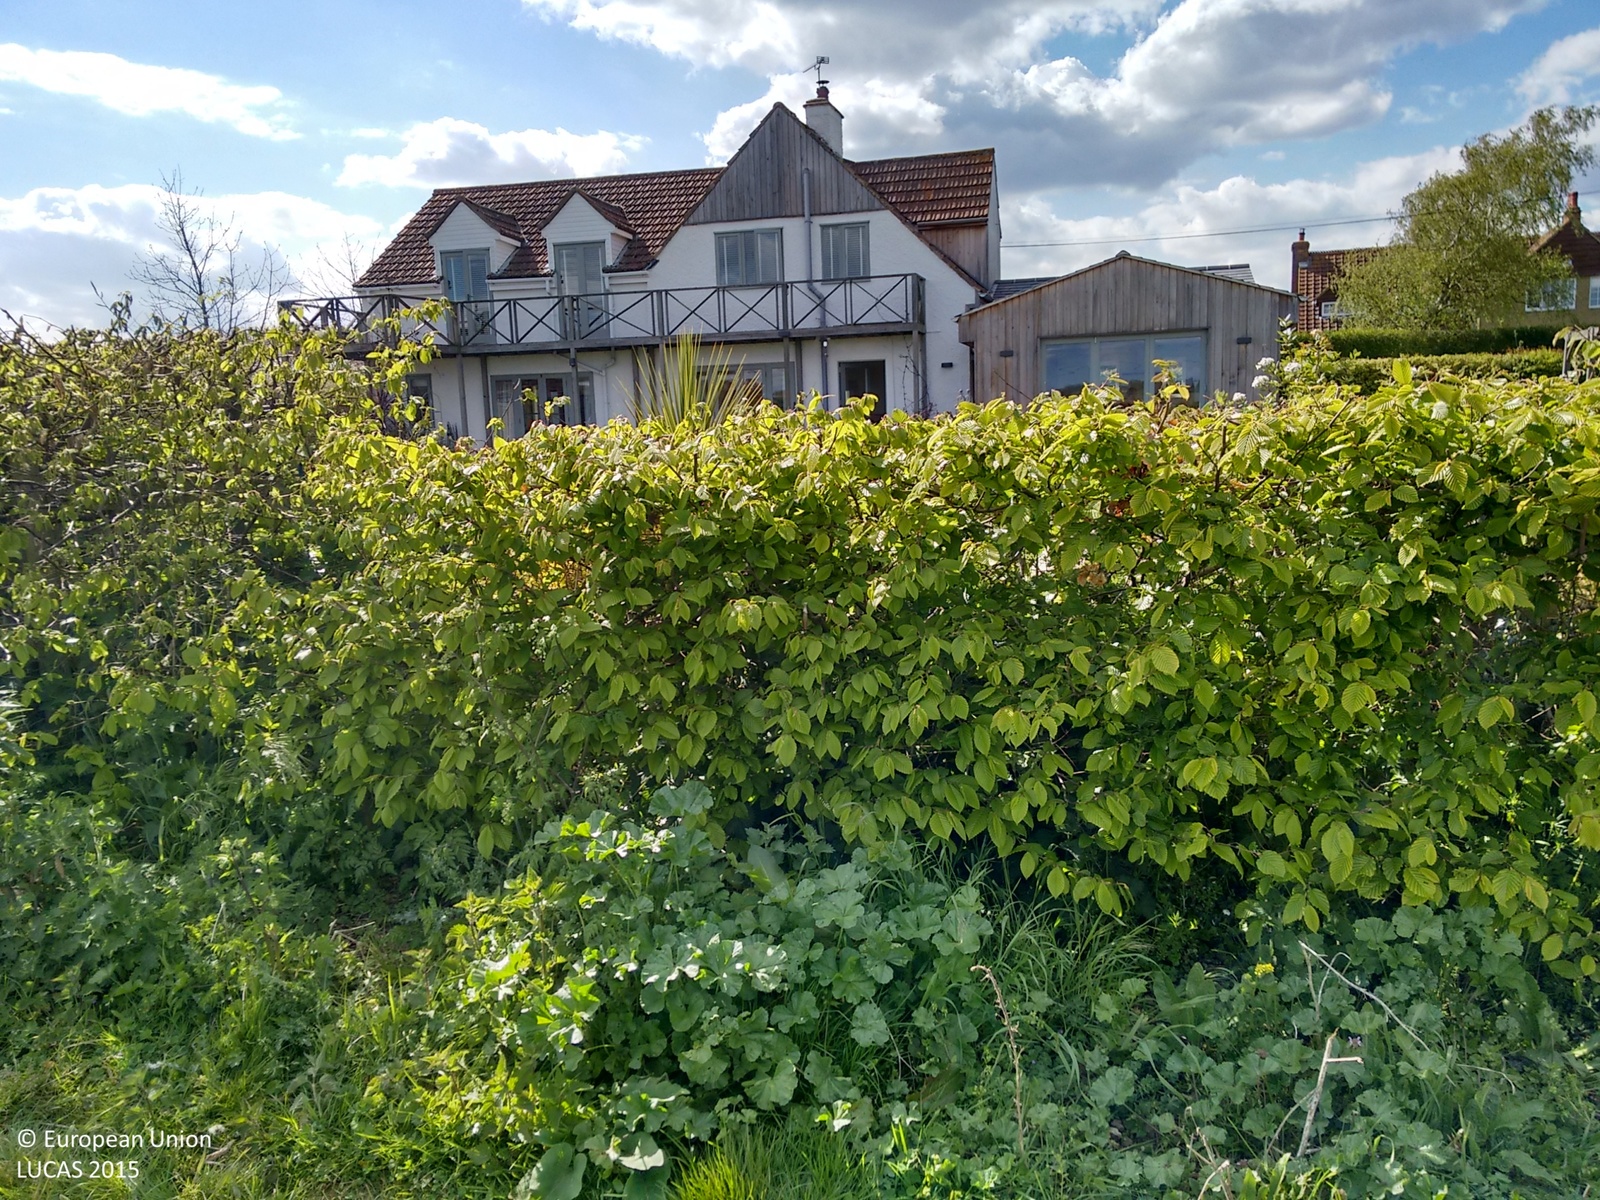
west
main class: Grassland
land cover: Grassland without tree/shrub cover
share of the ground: > 75 %
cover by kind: herbaceous plants 100 %
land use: Residential
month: April
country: GB
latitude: 51.3541
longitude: 0.6252
